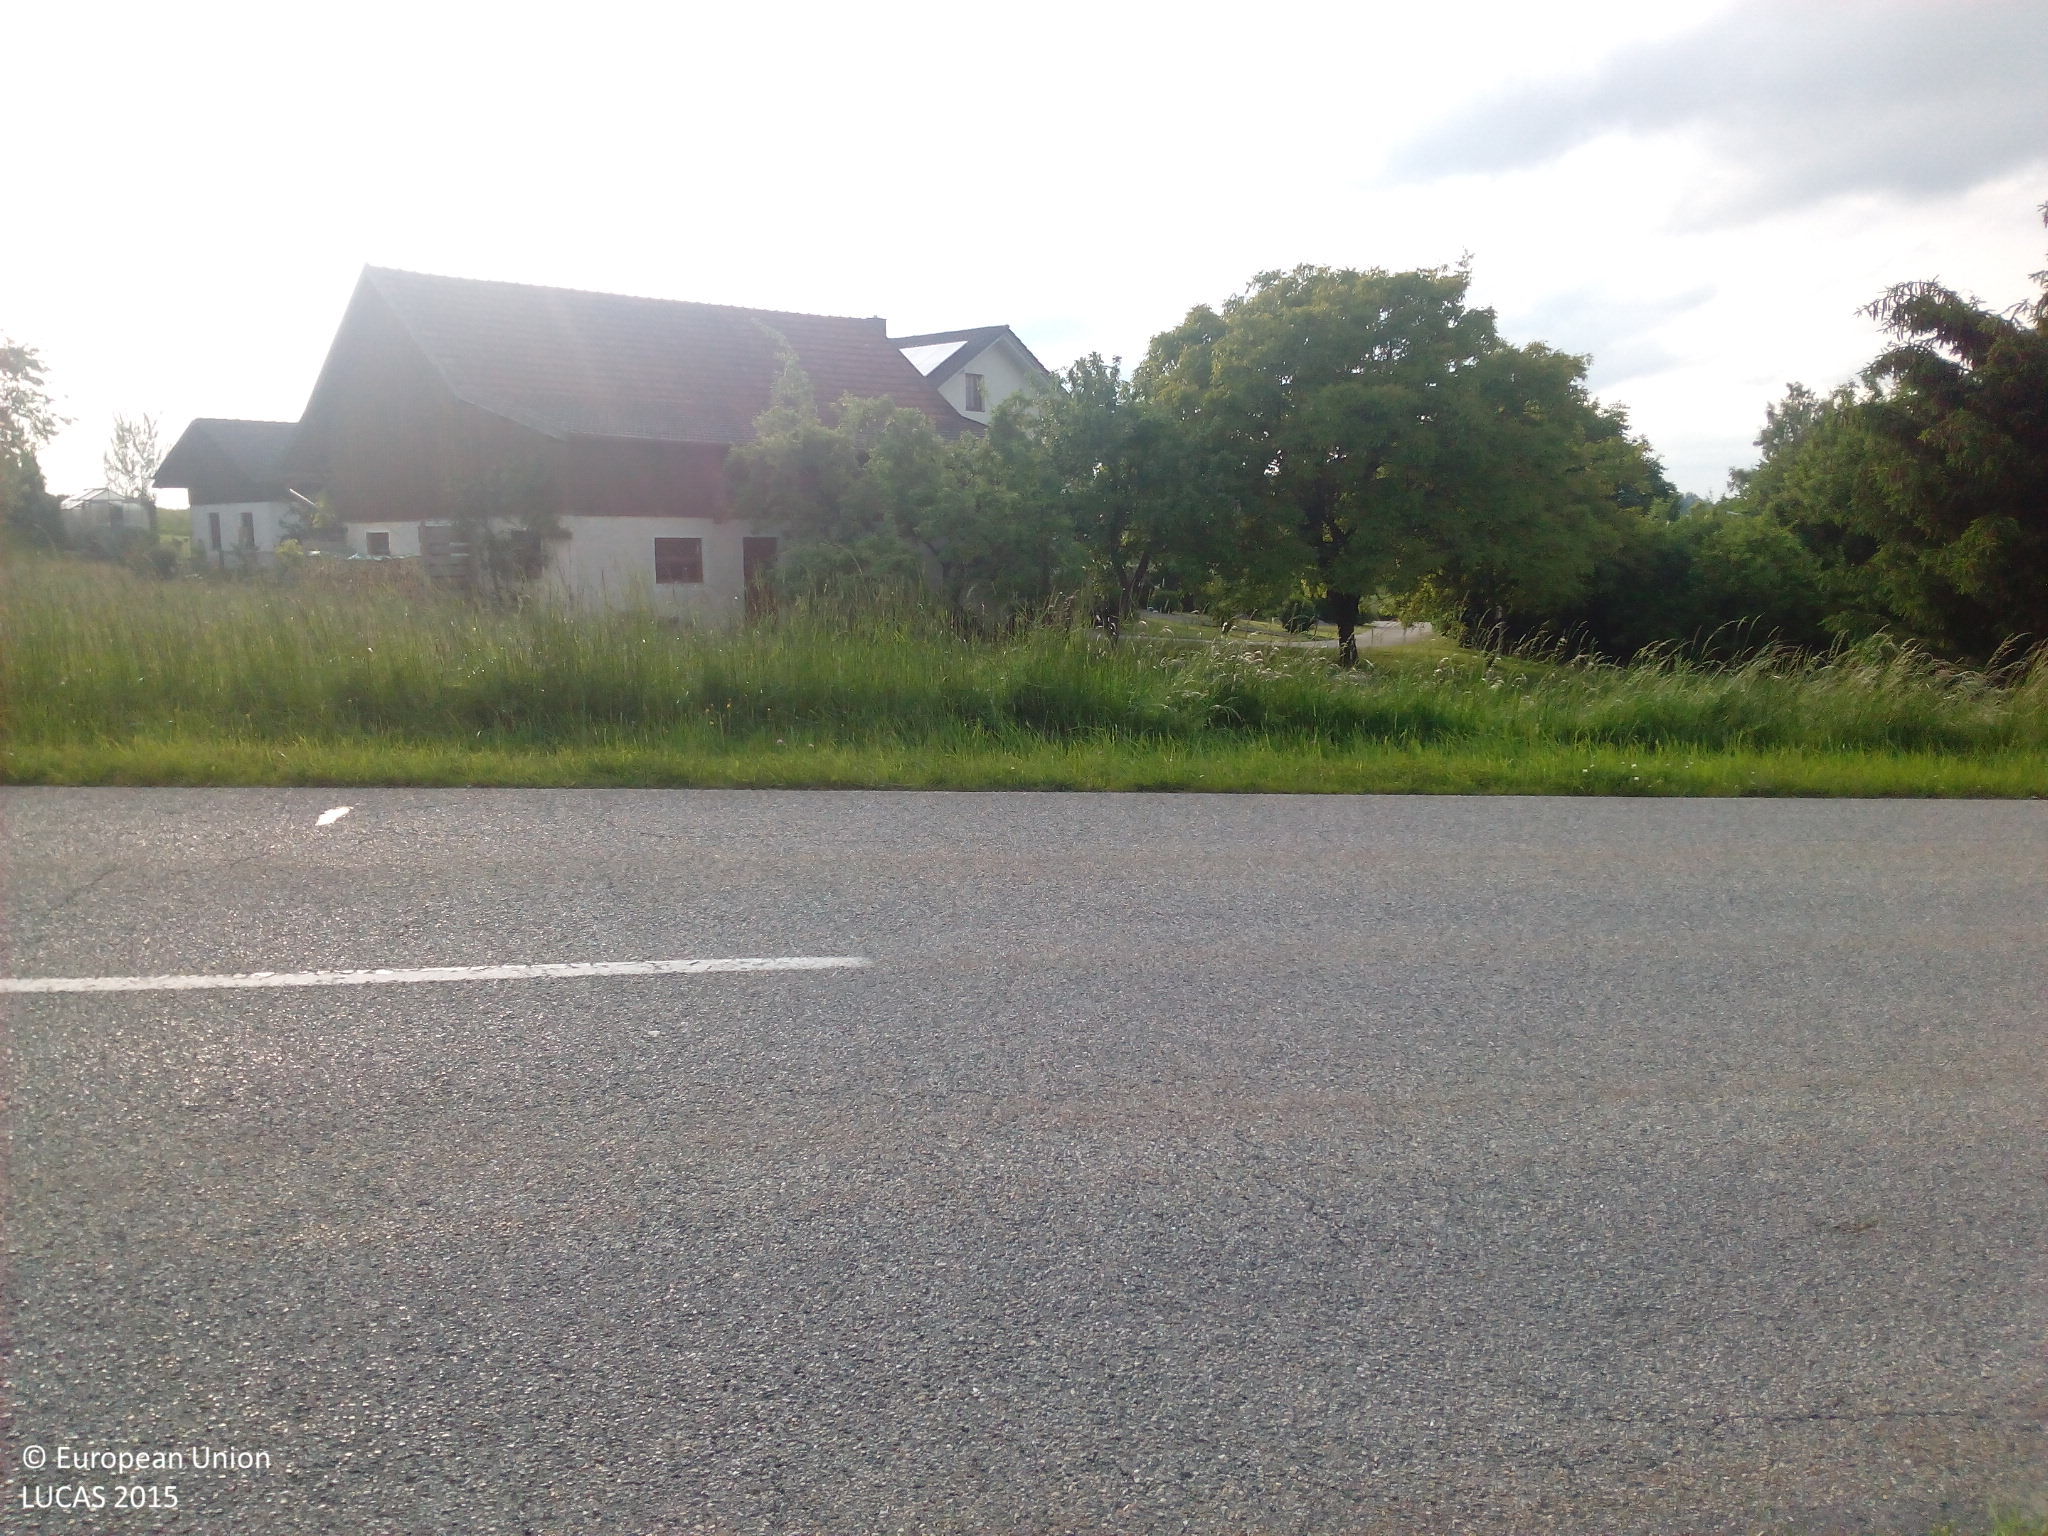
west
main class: Grassland
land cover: Grassland without tree/shrub cover
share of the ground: > 75 %
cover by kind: herbaceous plants 100 %
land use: Road transport
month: May
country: DE
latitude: 48.3597
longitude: 12.3879
